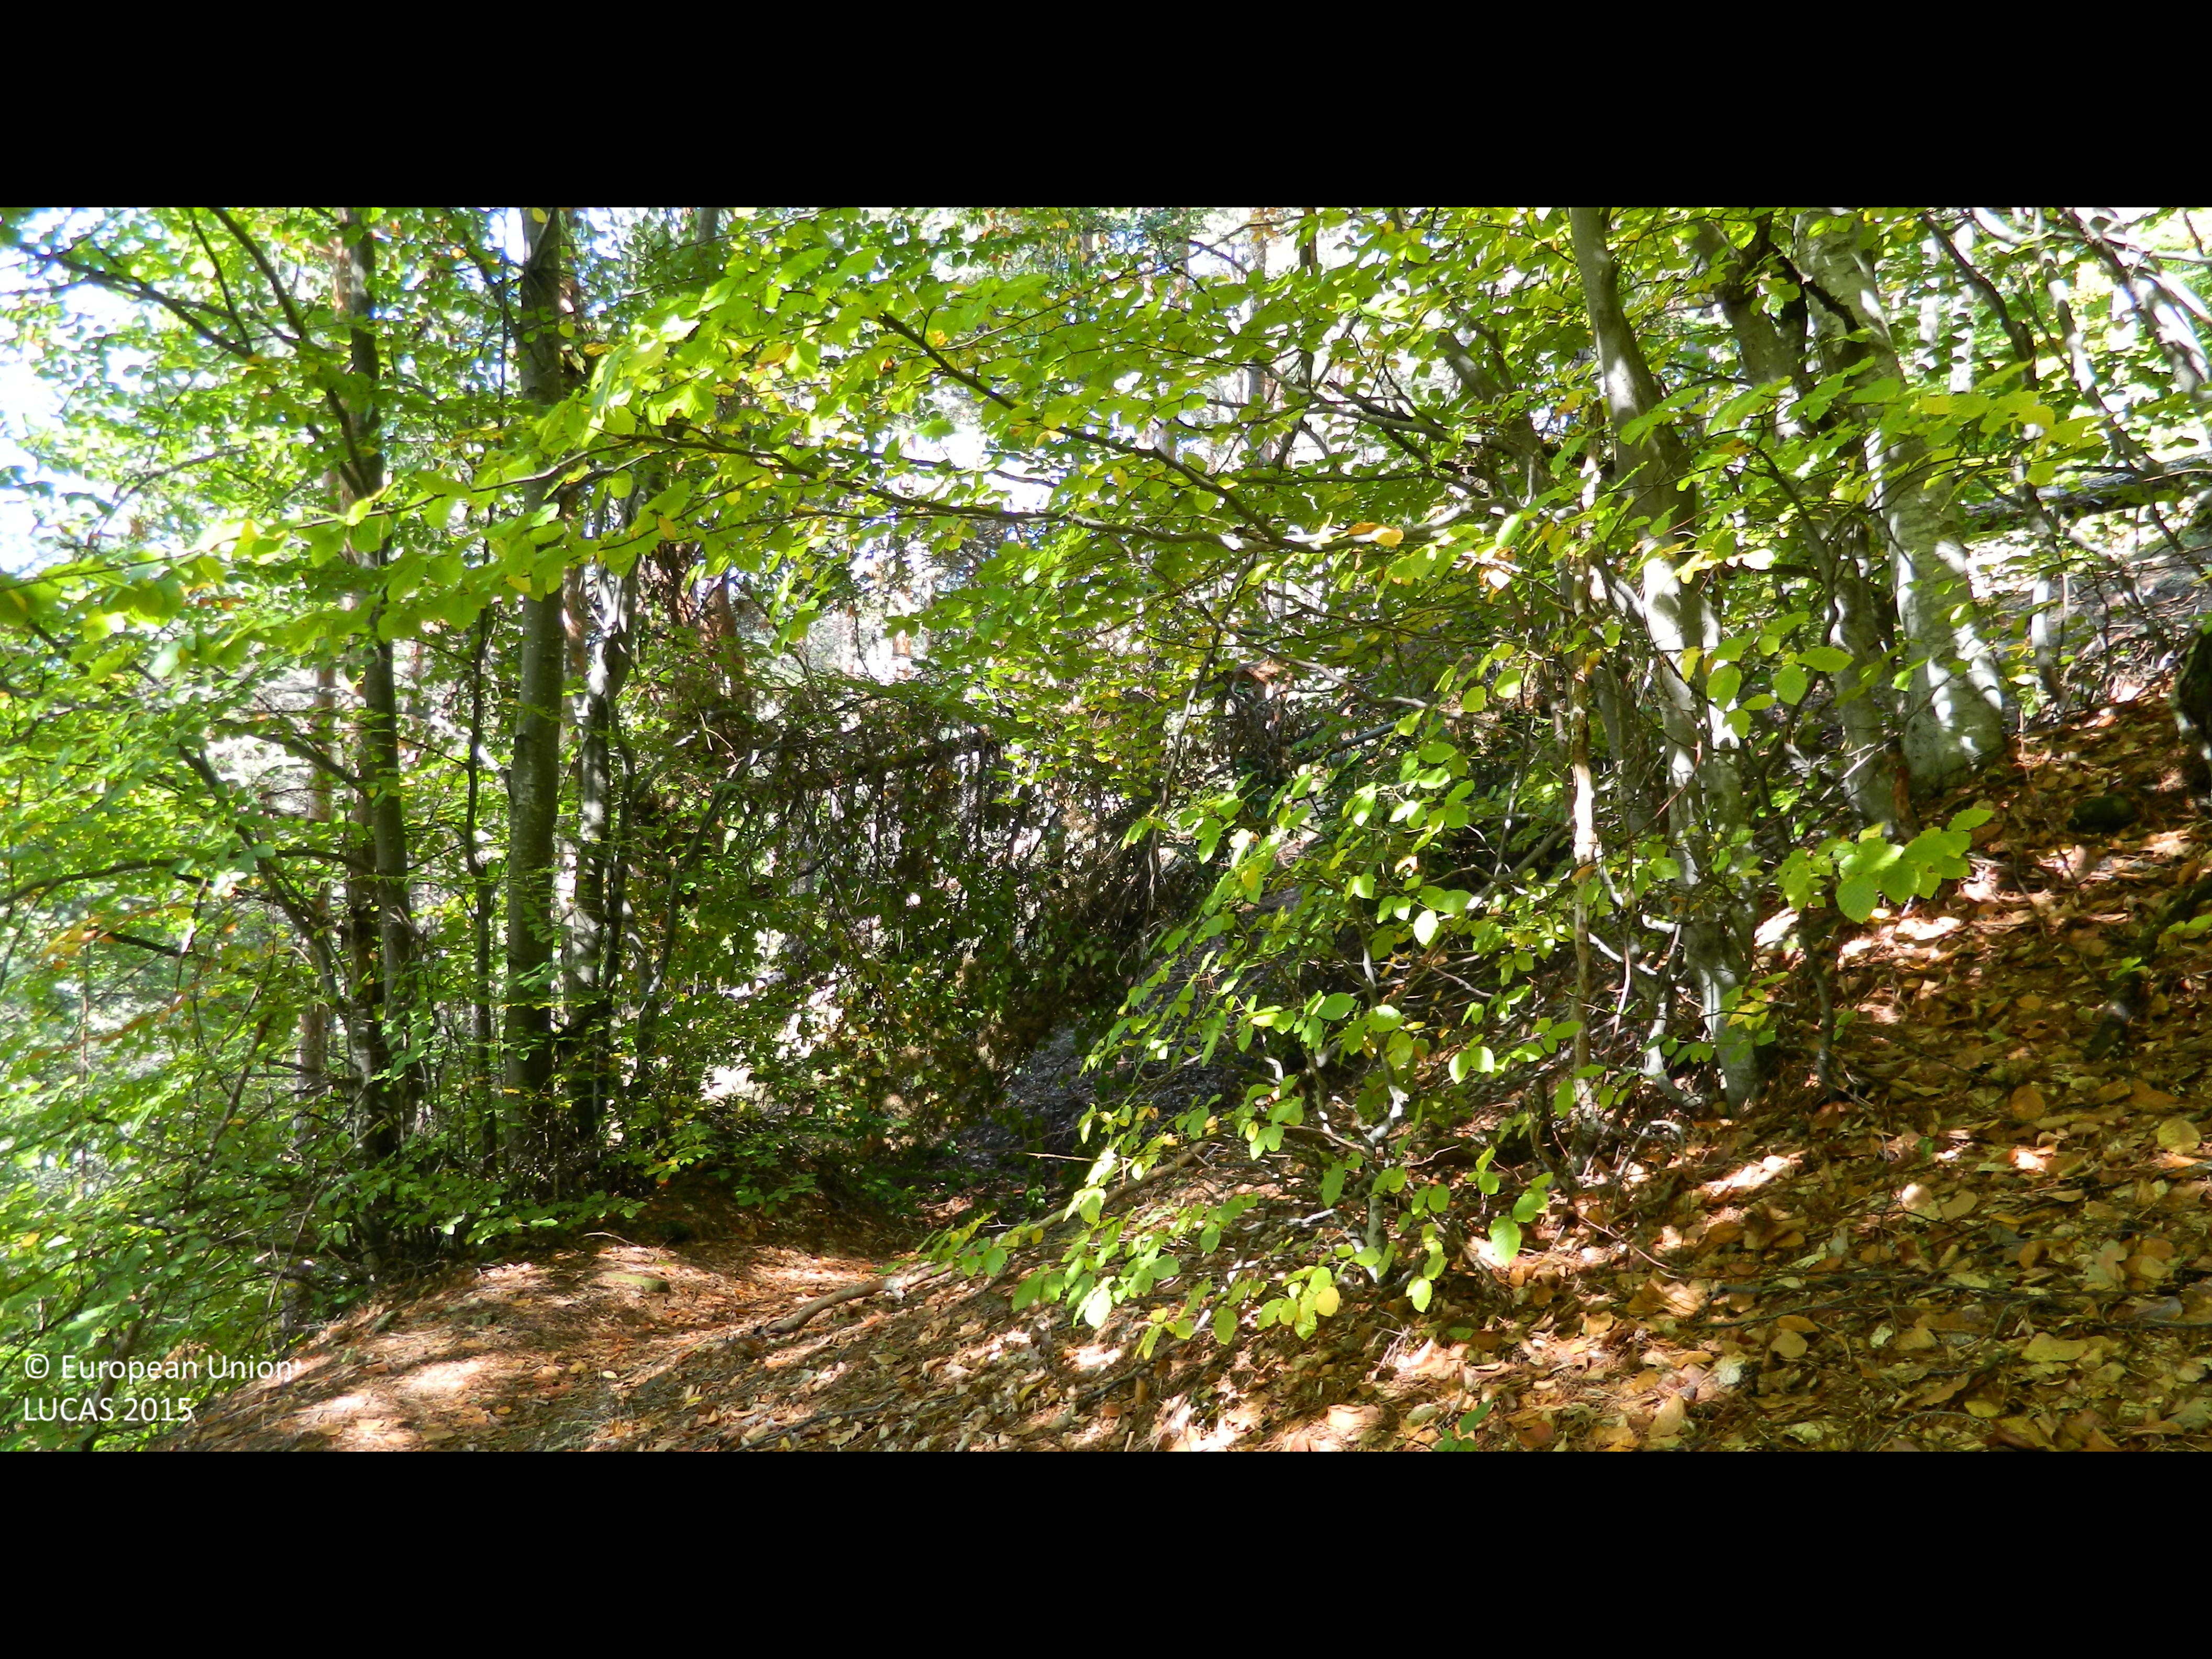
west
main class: Woodland
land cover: Pine dominated mixed woodland
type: mountainous beech forest
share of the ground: > 75 %
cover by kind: coniferous forest trees 50 %, broadleaved forest trees 50 %
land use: Forestry
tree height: > 5 m
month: October
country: BG
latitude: 41.6686
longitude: 24.9302
